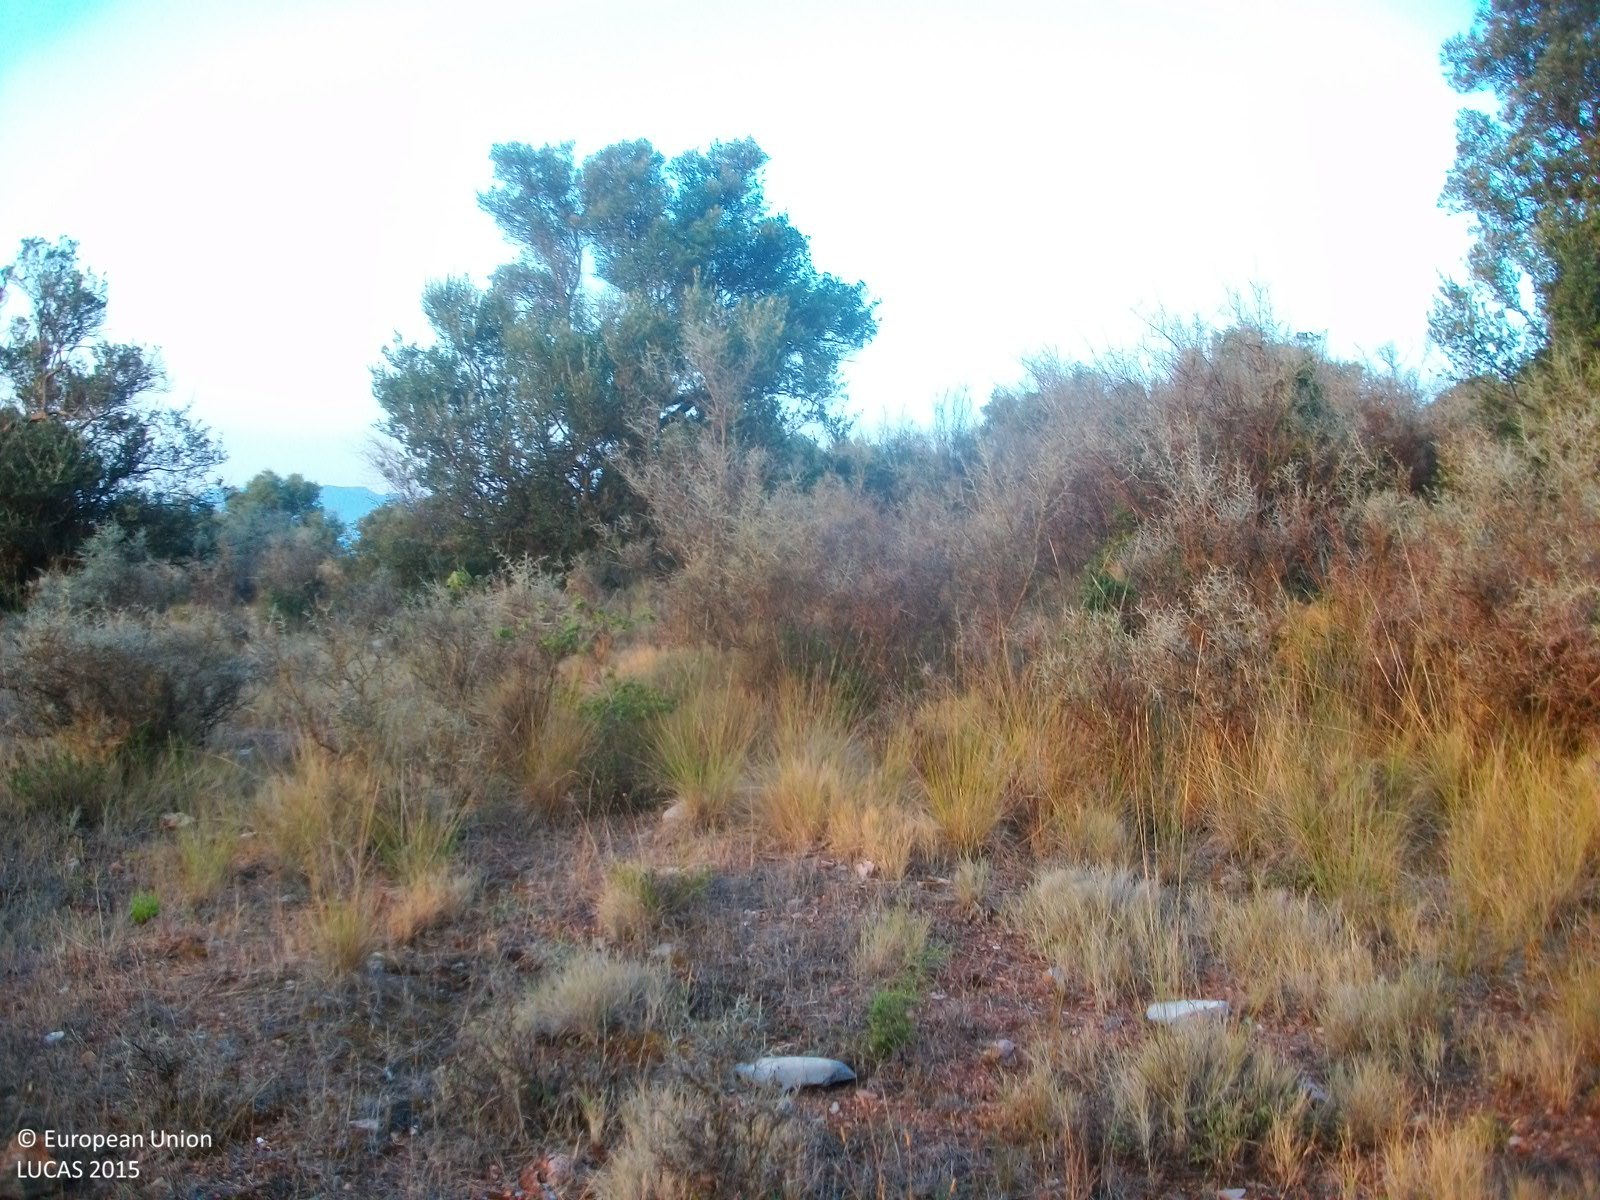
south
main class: Shrubland
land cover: Shrubland without tree cover
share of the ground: 25 - 50 %
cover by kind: herbaceous plants 70 %, shrubs 30 %
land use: Semi-natural and natural areas not in use
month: August
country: GR
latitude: 37.2696
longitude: 21.9206
